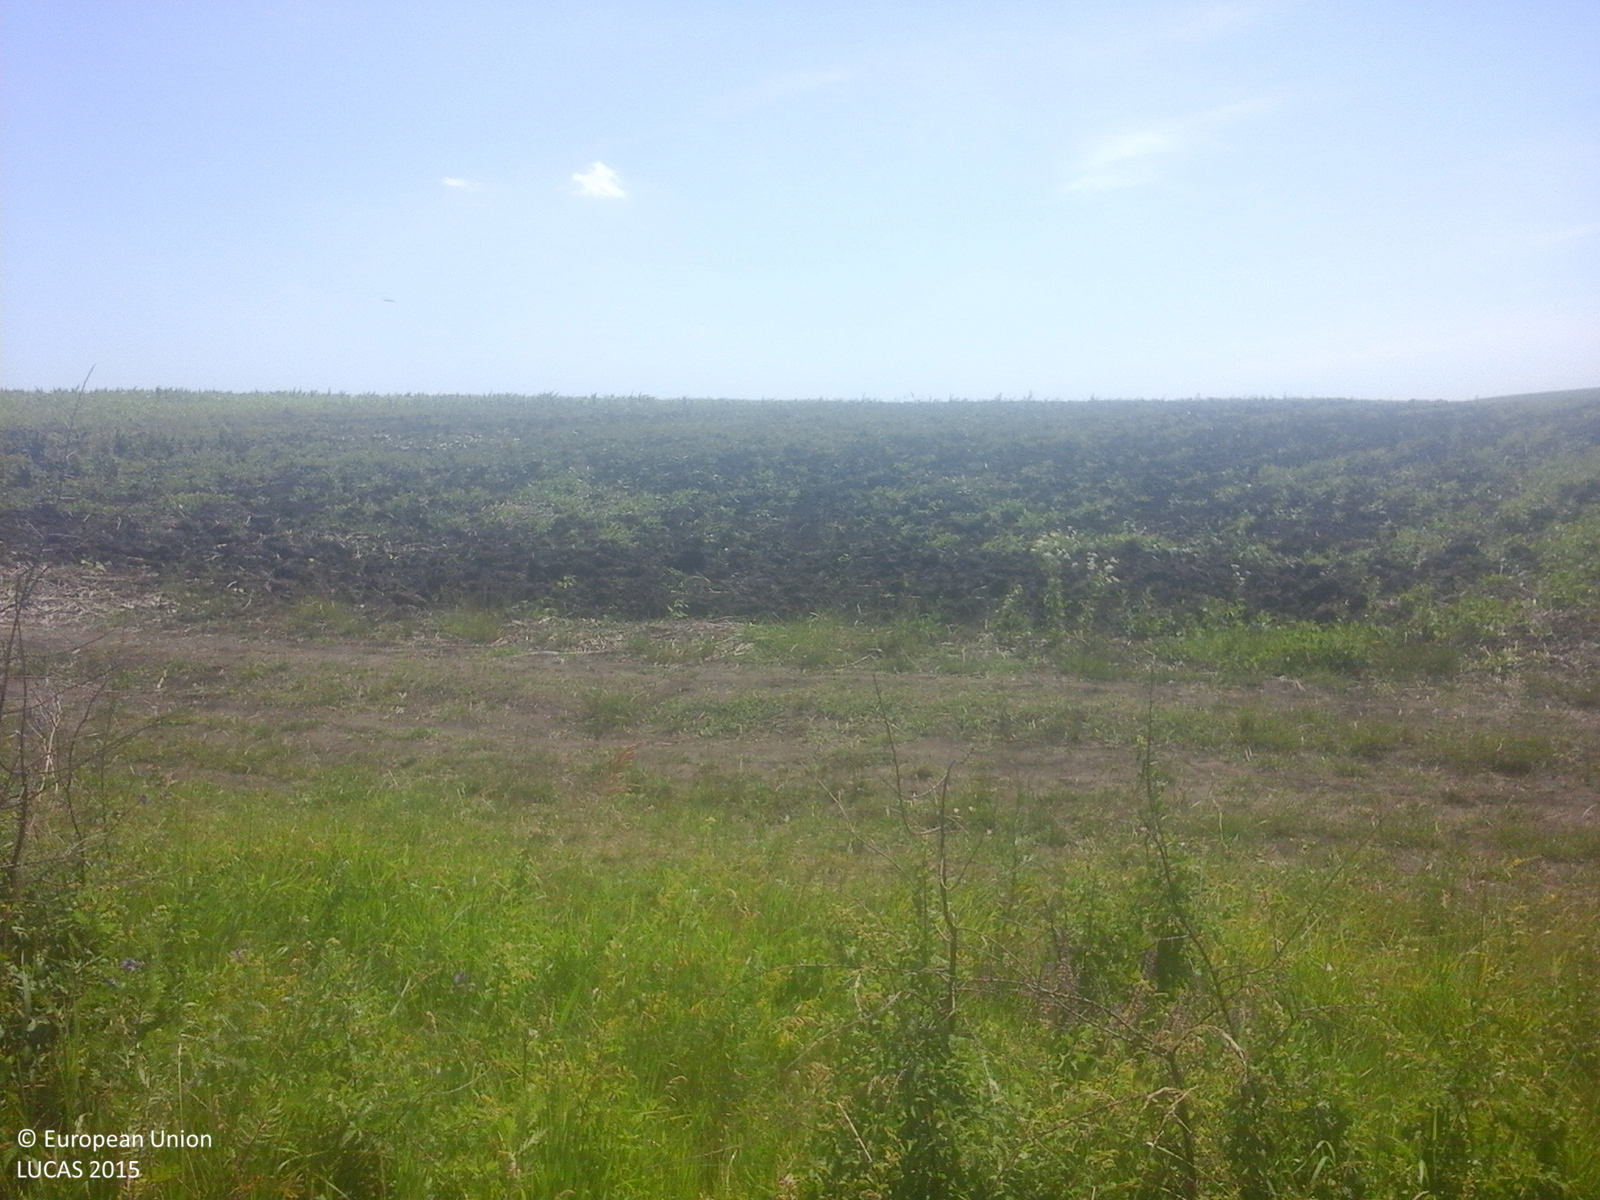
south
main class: Shrubland
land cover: Shrubland without tree cover
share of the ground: > 75 %
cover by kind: shrubs 80 %, herbaceous plants 20 %
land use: Semi-natural and natural areas not in use
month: June
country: RO
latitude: 47.9176
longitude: 26.8965
